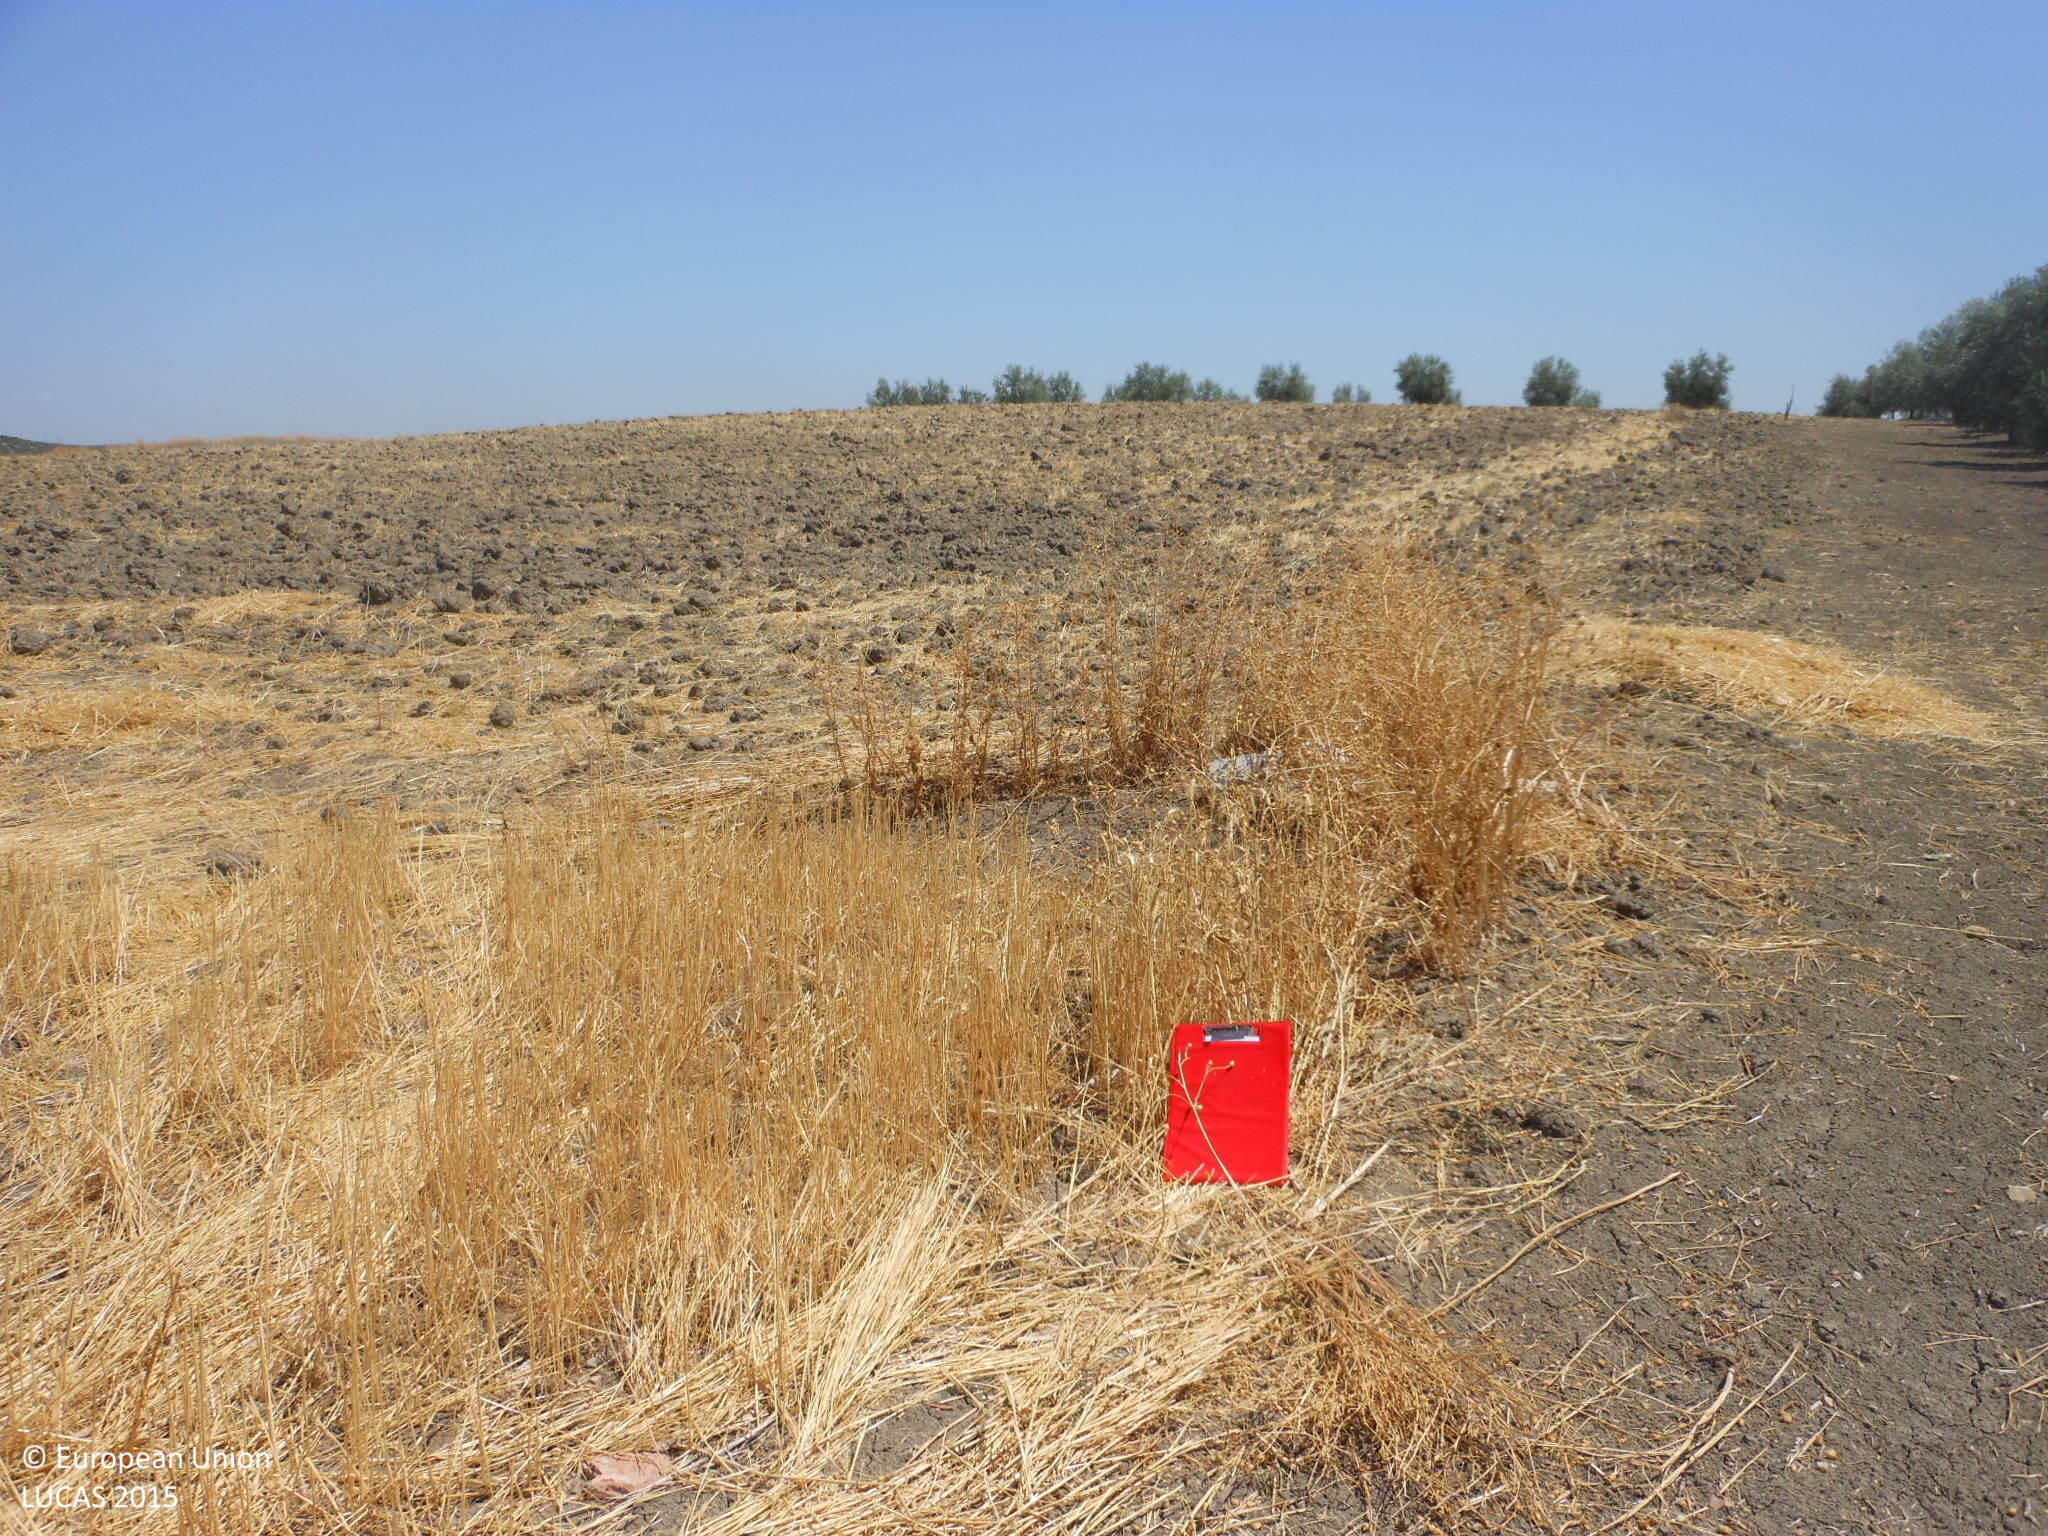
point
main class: Cropland
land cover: Common wheat
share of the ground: < 10 %
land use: Agriculture (excluding fallow land and kitchen gardens)
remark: Harvested field
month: July
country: ES
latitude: 37.2476
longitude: -5.3547
